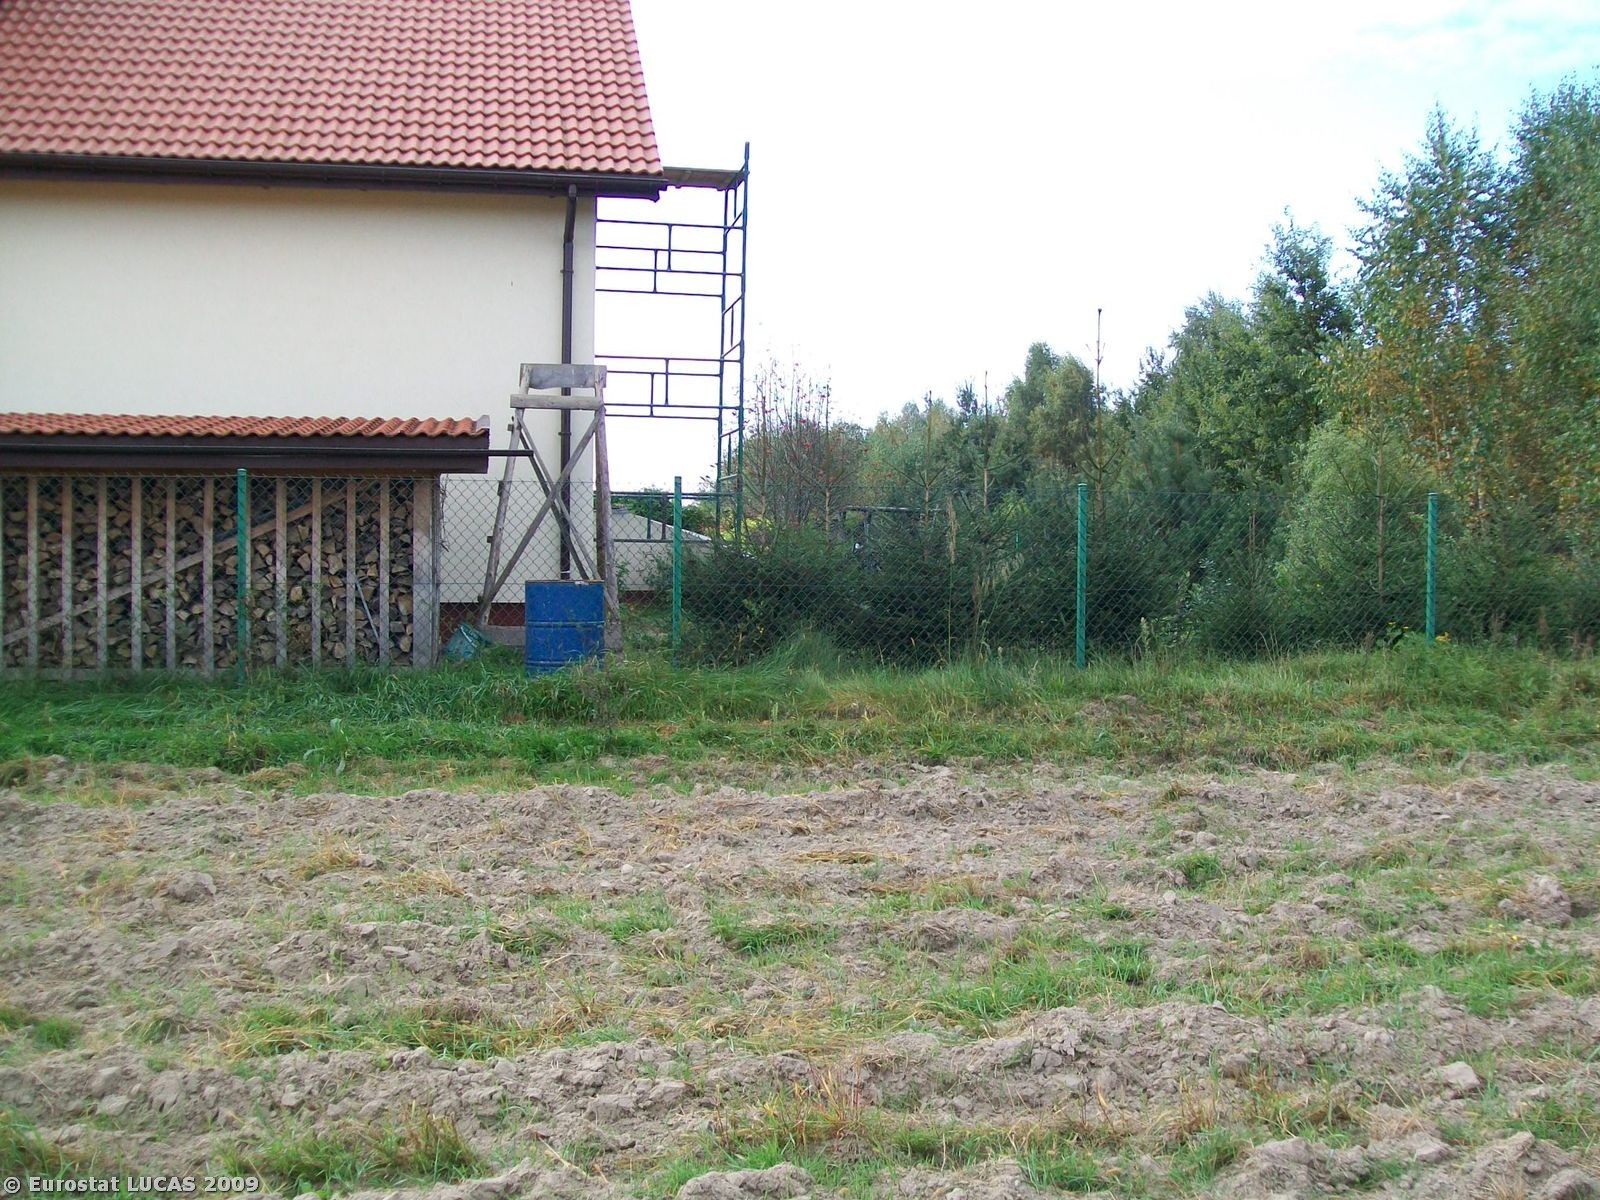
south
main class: Grassland
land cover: Grassland without tree/shrub cover
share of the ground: < 10 %
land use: Agriculture (excluding fallow land and kitchen gardens)
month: September
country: PL
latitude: 52.1895
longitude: 20.8228
